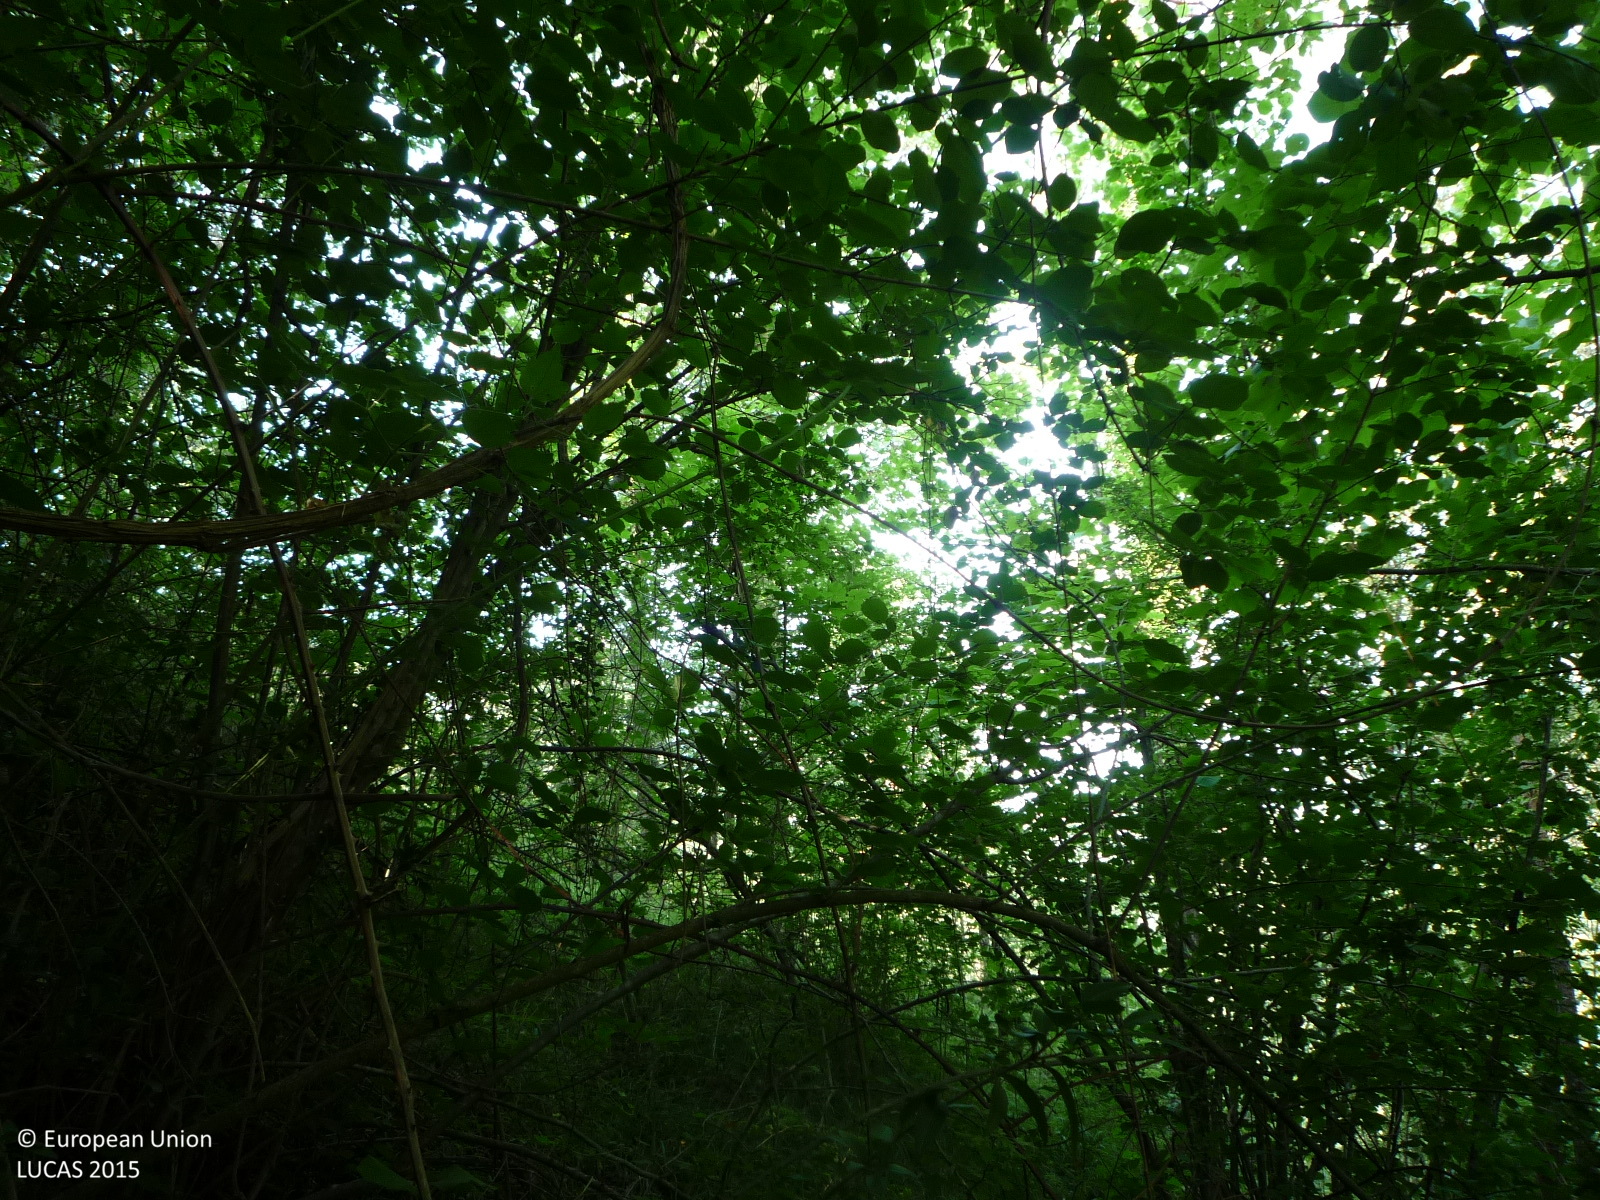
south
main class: Woodland
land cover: Other mixed woodland
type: thermophilous deciduous forest
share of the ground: > 75 %
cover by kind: broadleaved forest trees 75 %, coniferous forest trees 25 %
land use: Forestry
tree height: > 5 m
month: July
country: ES
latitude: 42.1312
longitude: 1.9196
